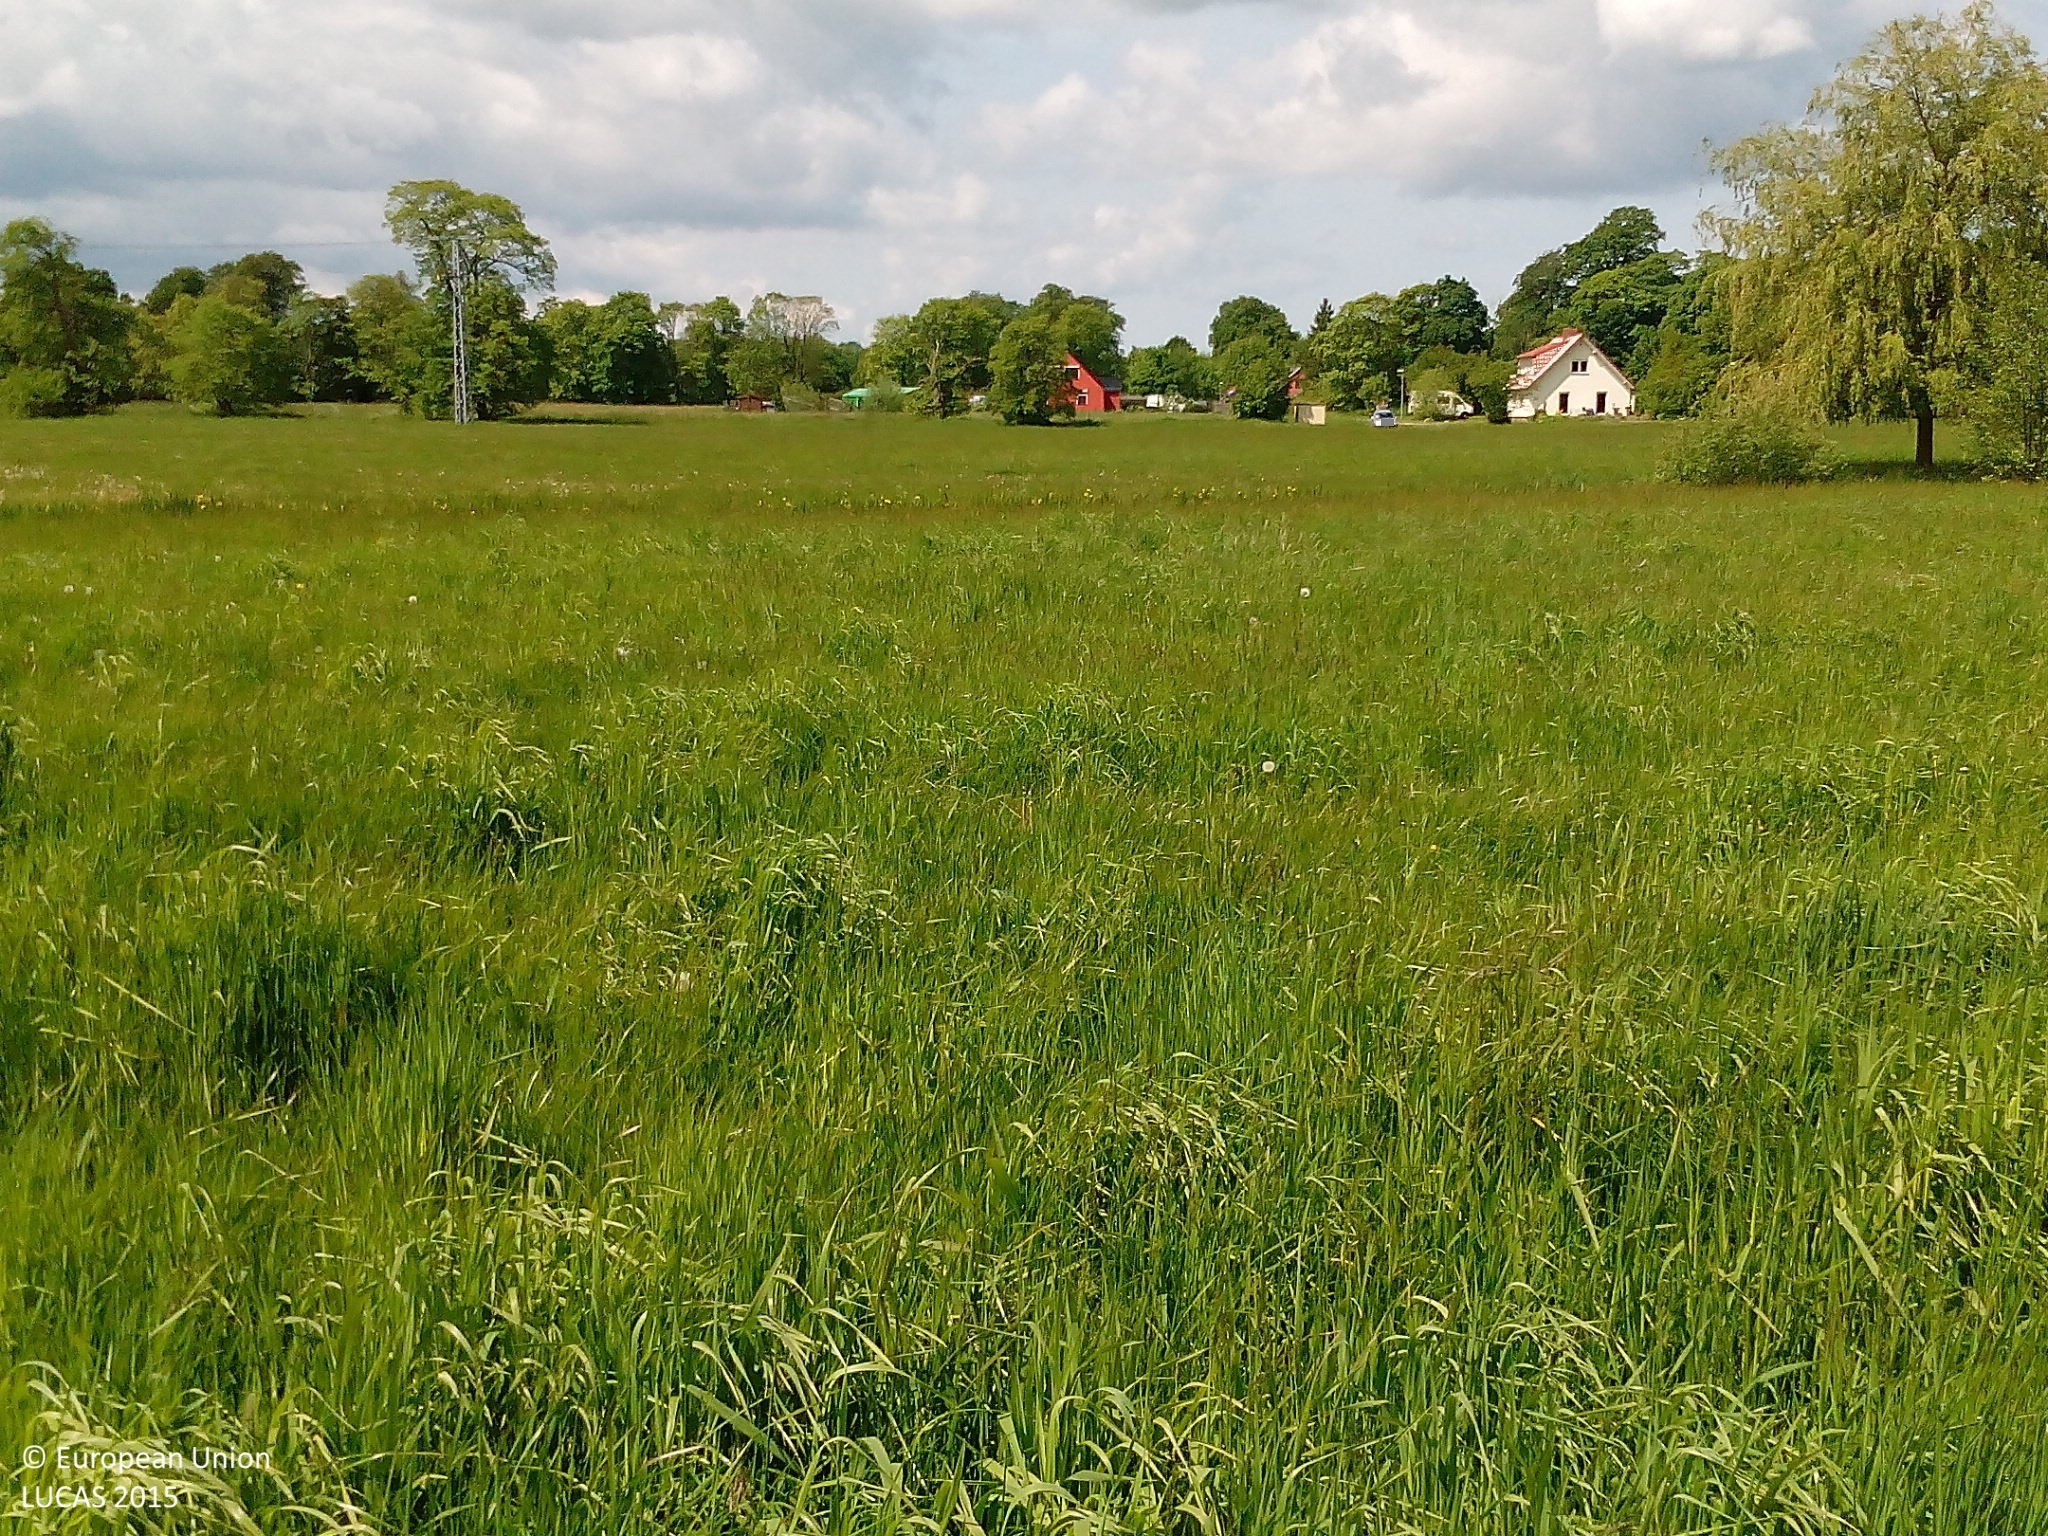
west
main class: Grassland
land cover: Grassland without tree/shrub cover
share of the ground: > 75 %
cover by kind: herbaceous plants 100 %
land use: Agriculture (excluding fallow land and kitchen gardens)
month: May
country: DE
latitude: 54.4539
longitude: 13.3153
